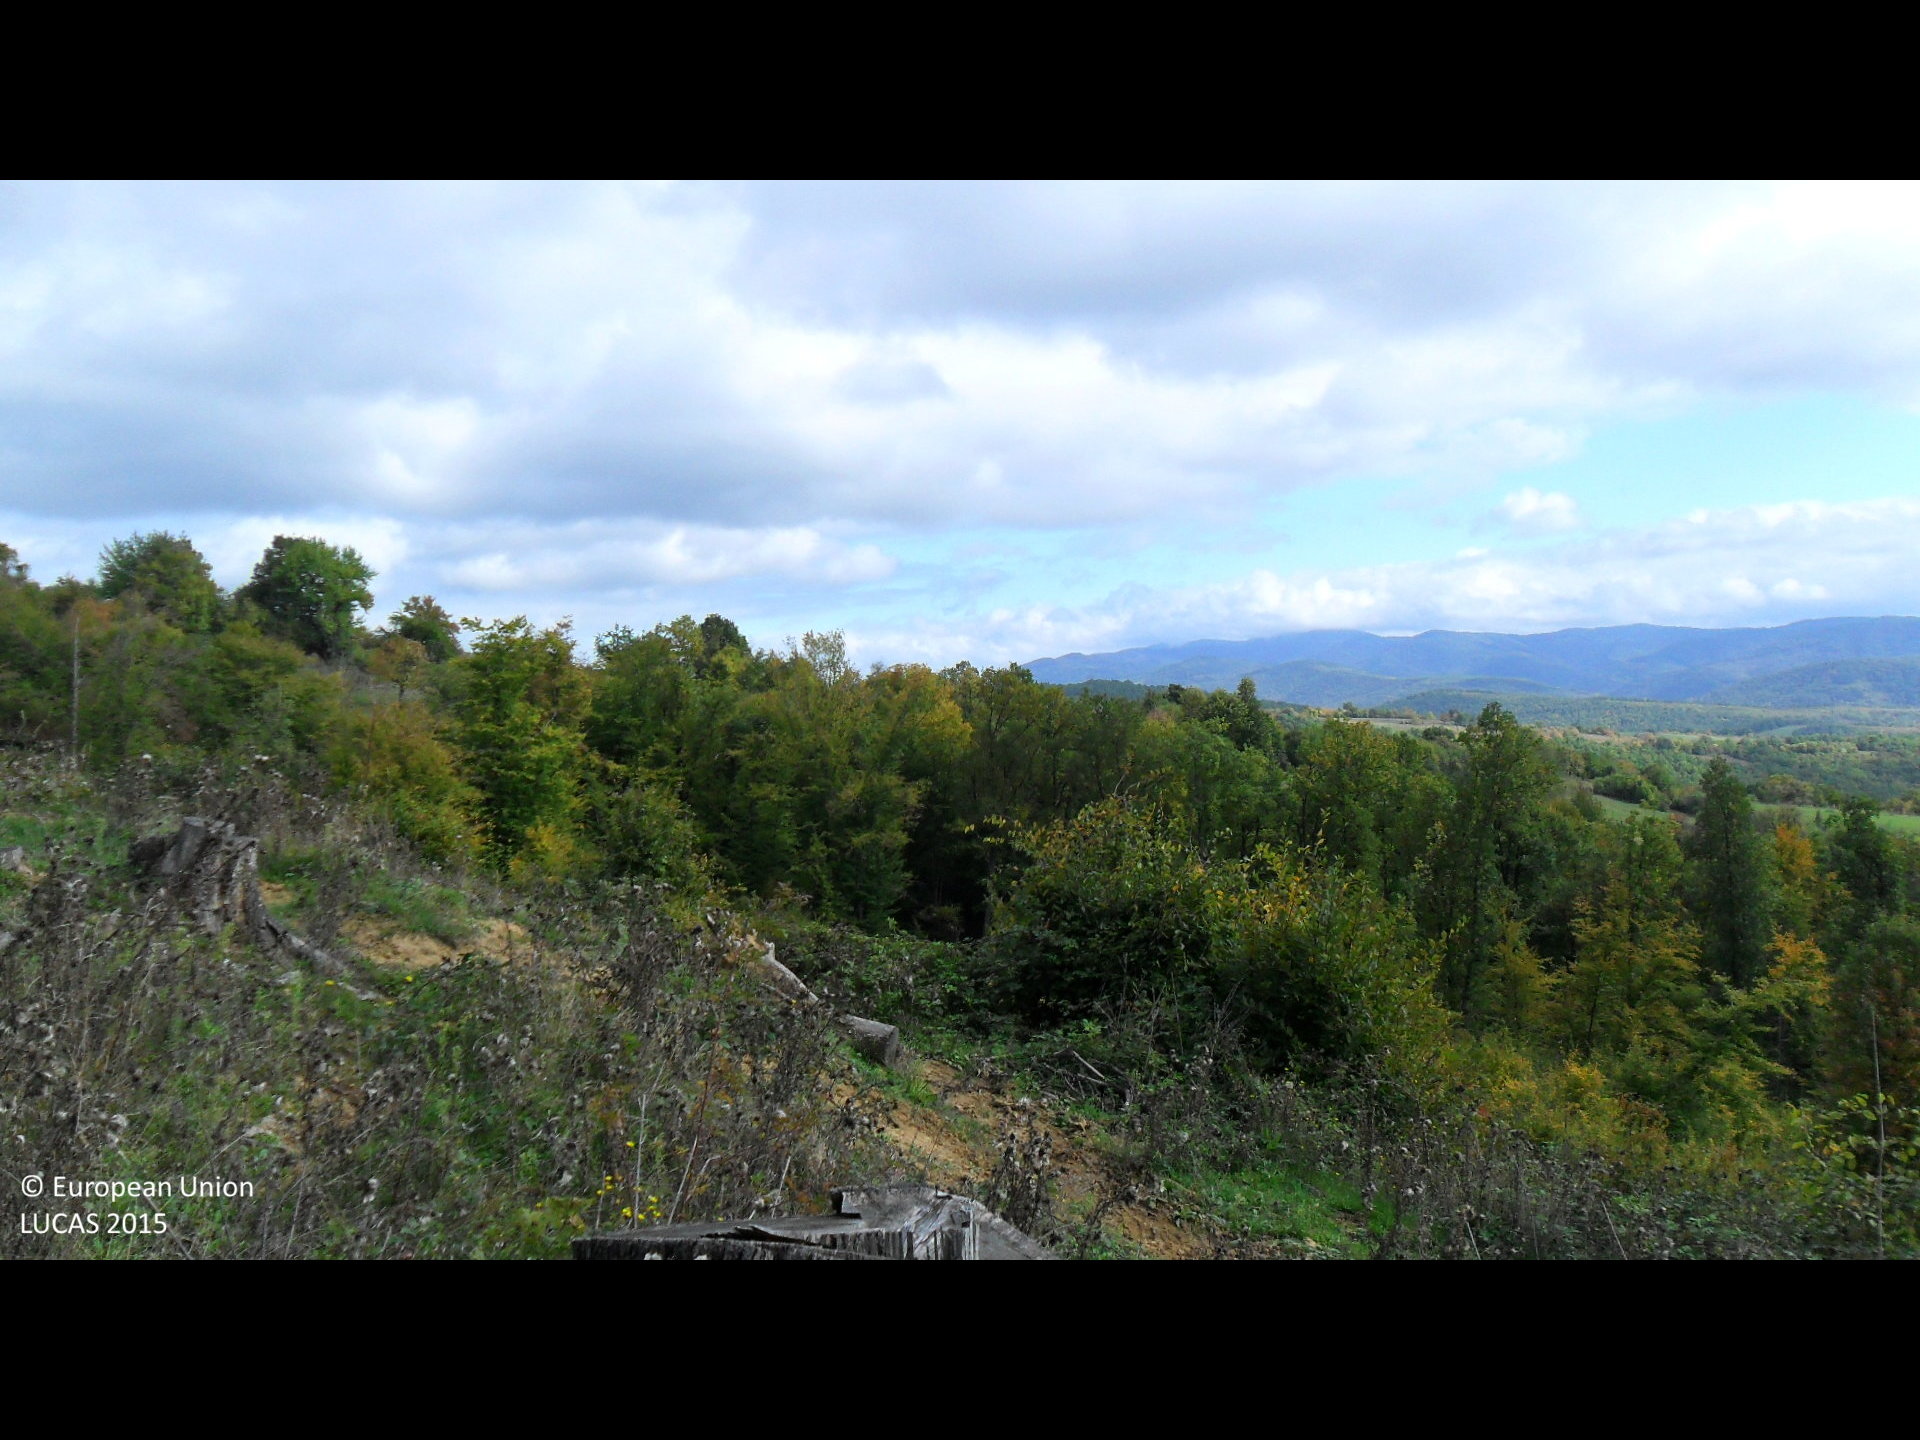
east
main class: Grassland
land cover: Grassland with sparse tree/shrub cover
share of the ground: > 75 %
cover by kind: herbaceous plants 90 %, broadleaved forest trees 5 %, shrubs 5 %
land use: Agriculture (excluding fallow land and kitchen gardens)
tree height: < 5 m
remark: Clear cut
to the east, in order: Grassland with sparse tree/shrub cover; Broadleaved woodland; Grassland with sparse tree/shrub cover
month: October
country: BG
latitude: 43.0374
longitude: 26.1578
